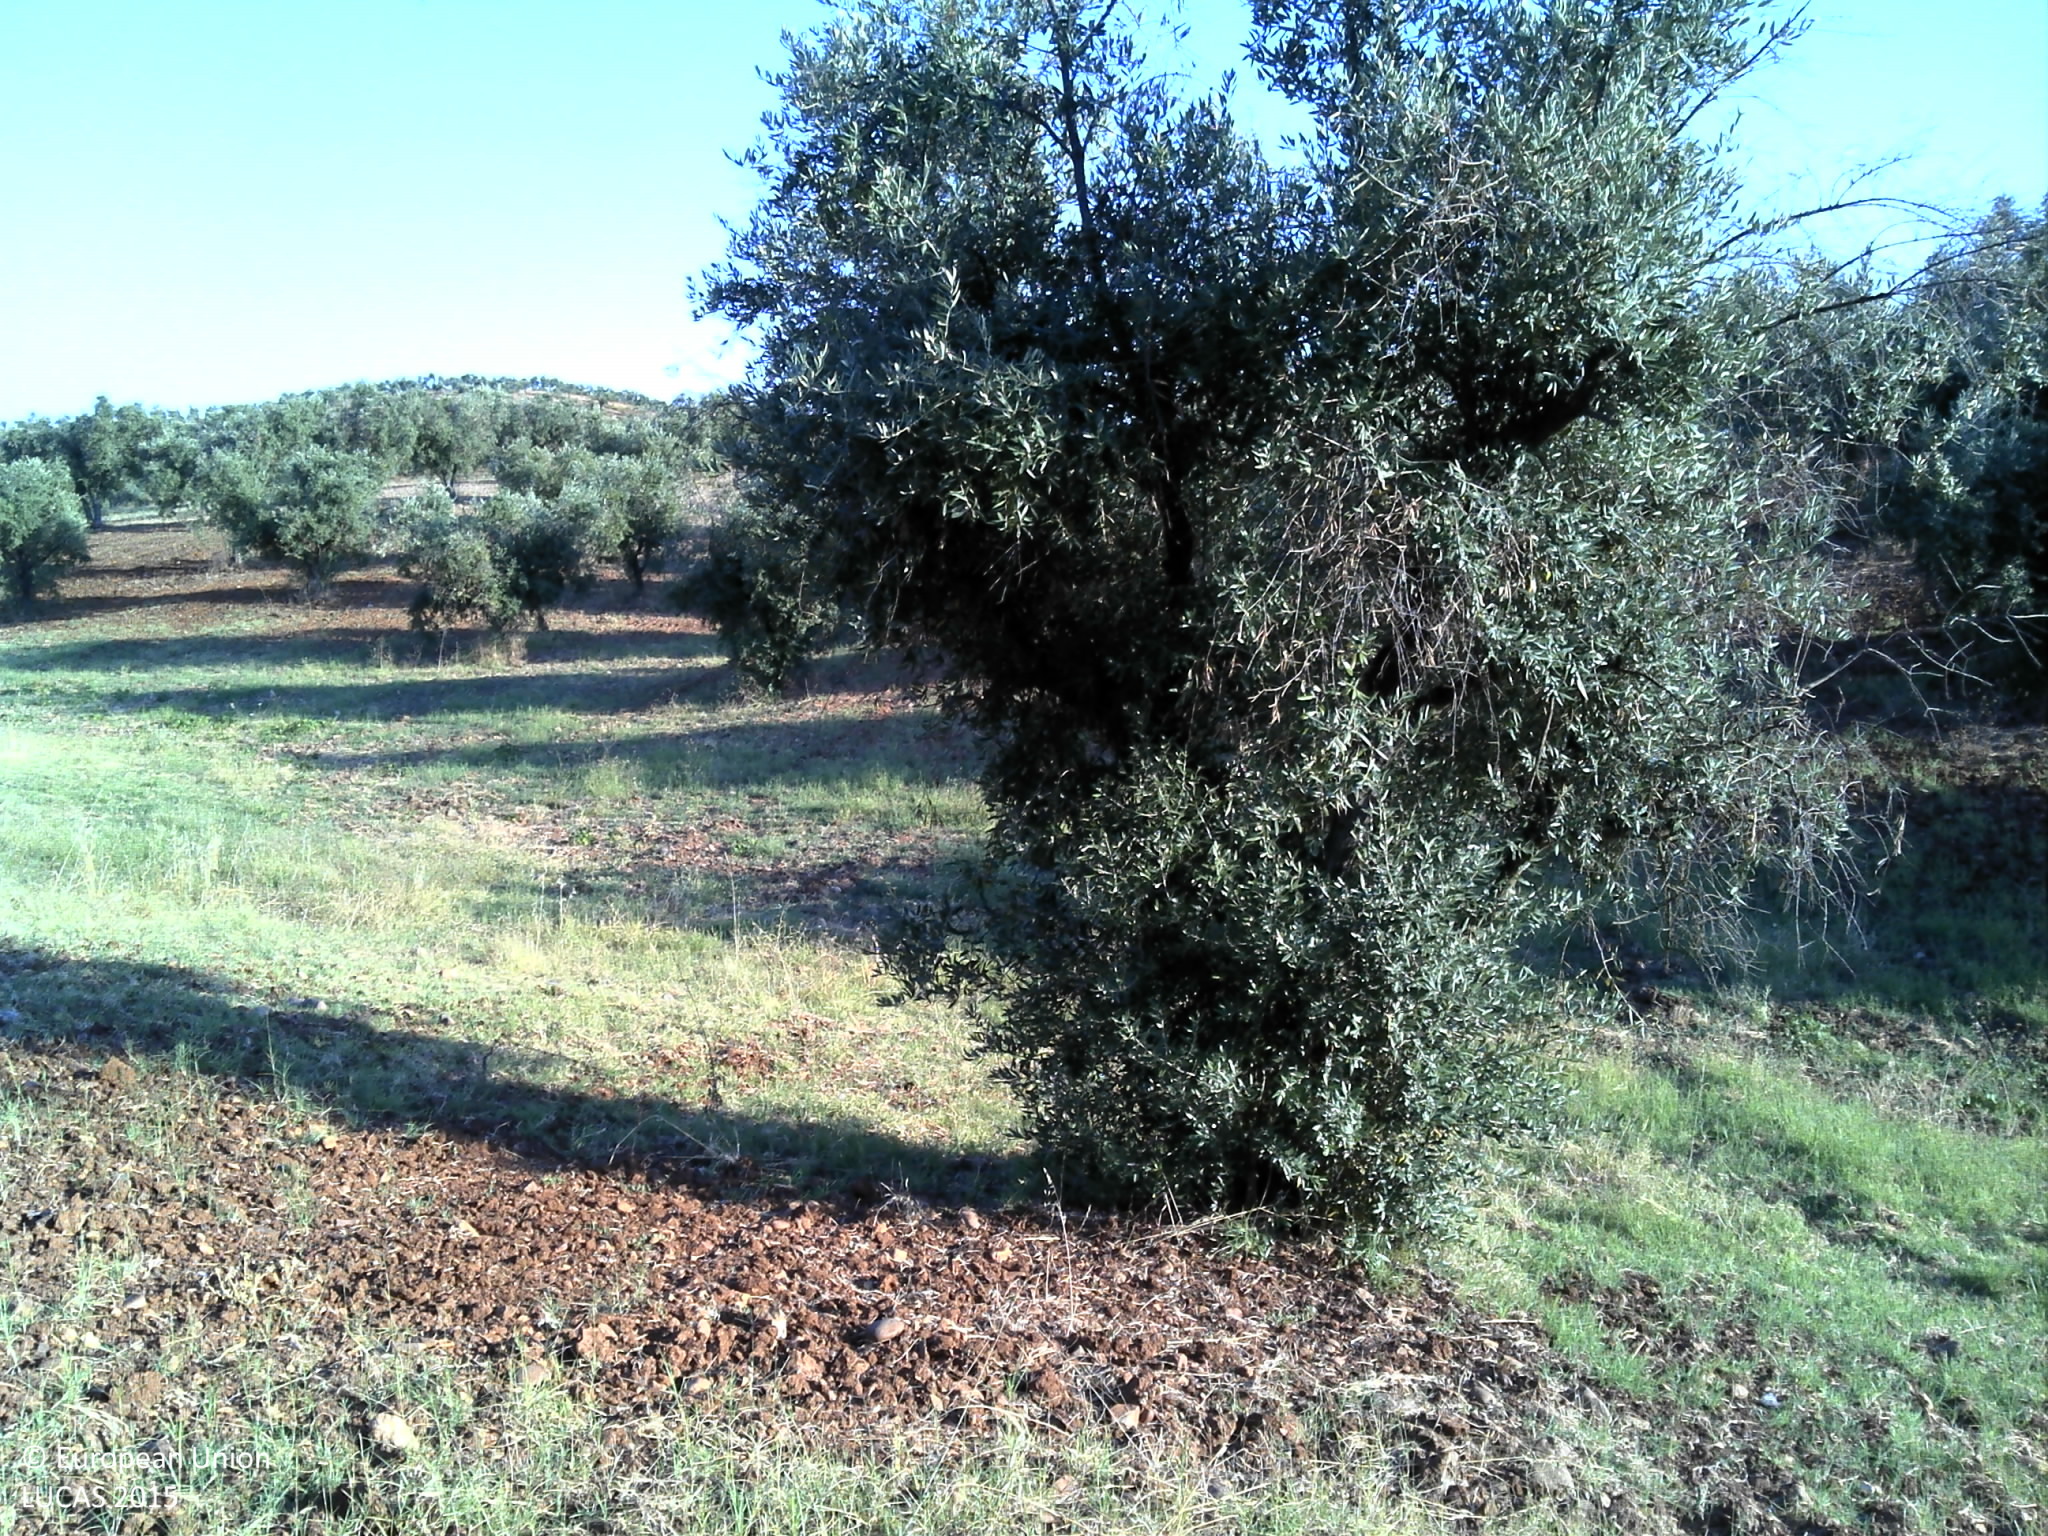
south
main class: Cropland
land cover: Olive groves
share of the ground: 25 - 50 %
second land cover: Grassland without tree/shrub cover
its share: 10 - 25 %
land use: Agriculture (excluding fallow land and kitchen gardens)
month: June
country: PT
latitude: 38.1258
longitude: -7.6028
